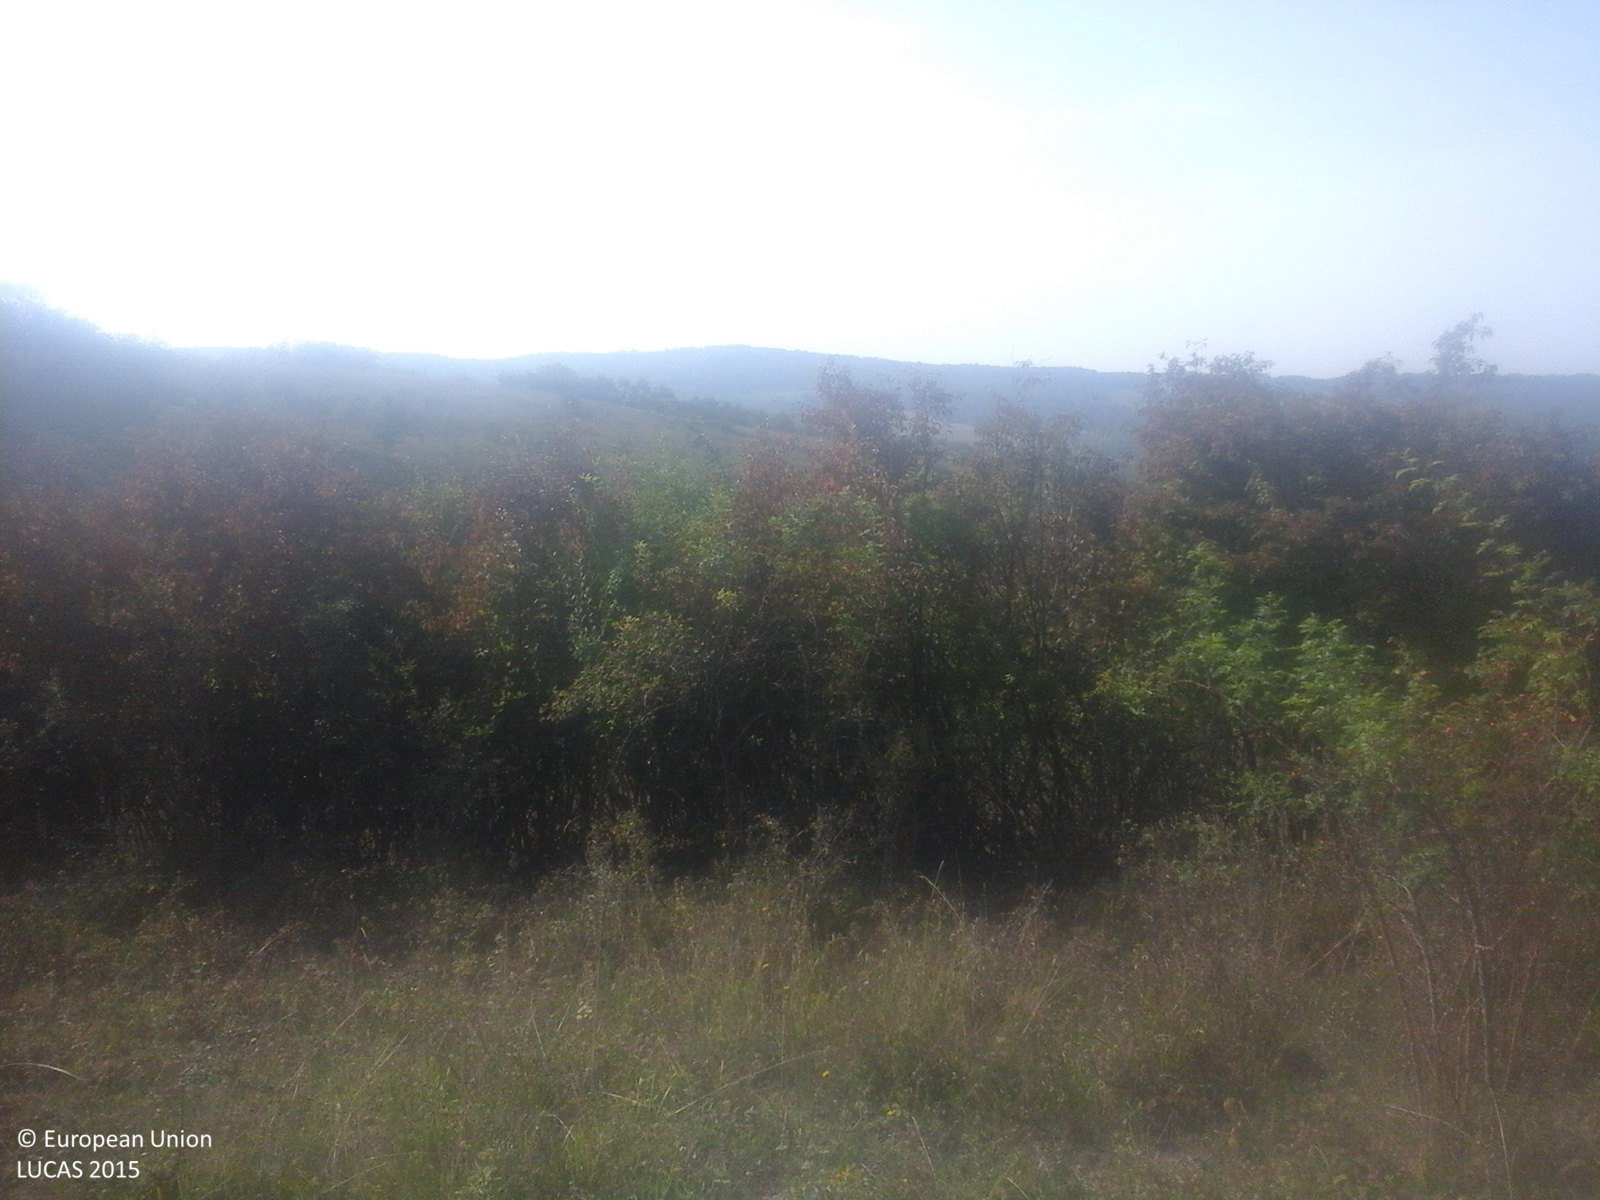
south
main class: Grassland
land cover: Grassland without tree/shrub cover
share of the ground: > 75 %
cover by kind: herbaceous plants 100 %
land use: Agriculture (excluding fallow land and kitchen gardens)
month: September
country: RO
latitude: 47.2064
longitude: 23.2028
